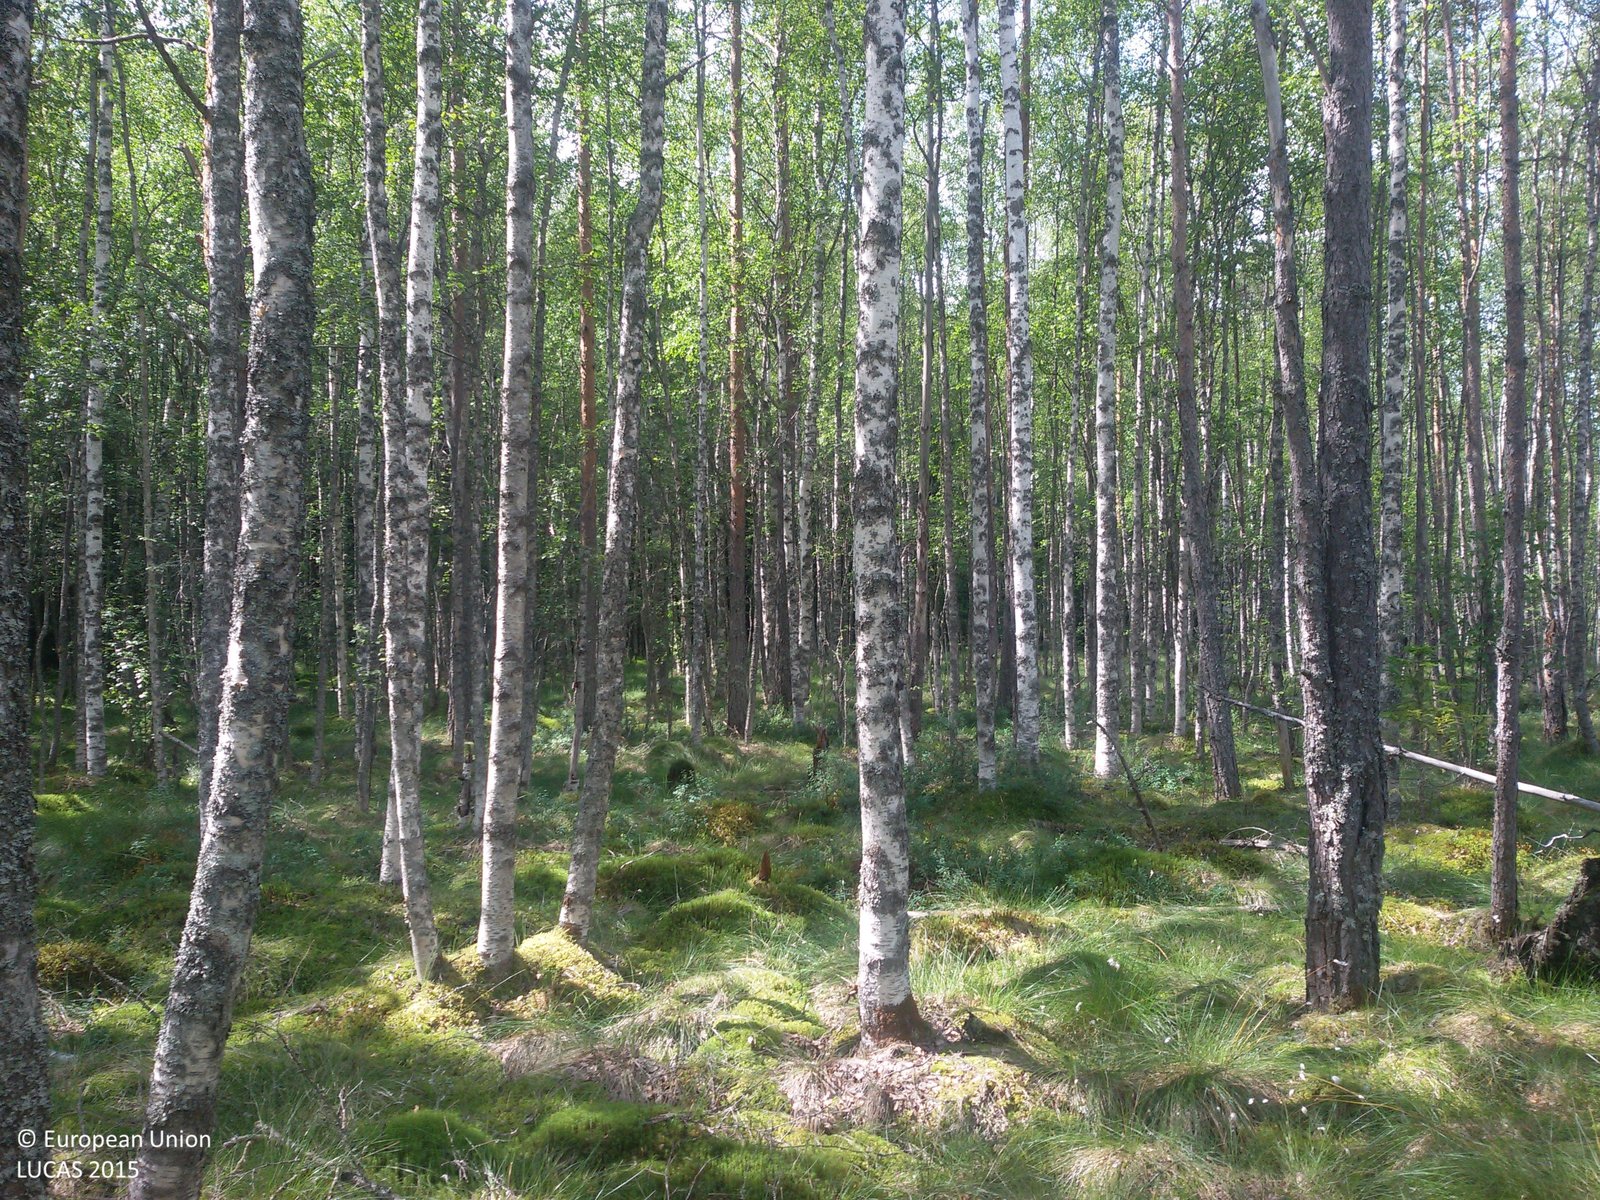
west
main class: Woodland
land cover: Broadleaved woodland
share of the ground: > 75 %
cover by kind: broadleaved forest trees 80 %, herbaceous plants 10 %, lichens and mosses 10 %
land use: Semi-natural and natural areas not in use
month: July
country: SE
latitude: 60.5239
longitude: 15.0343
